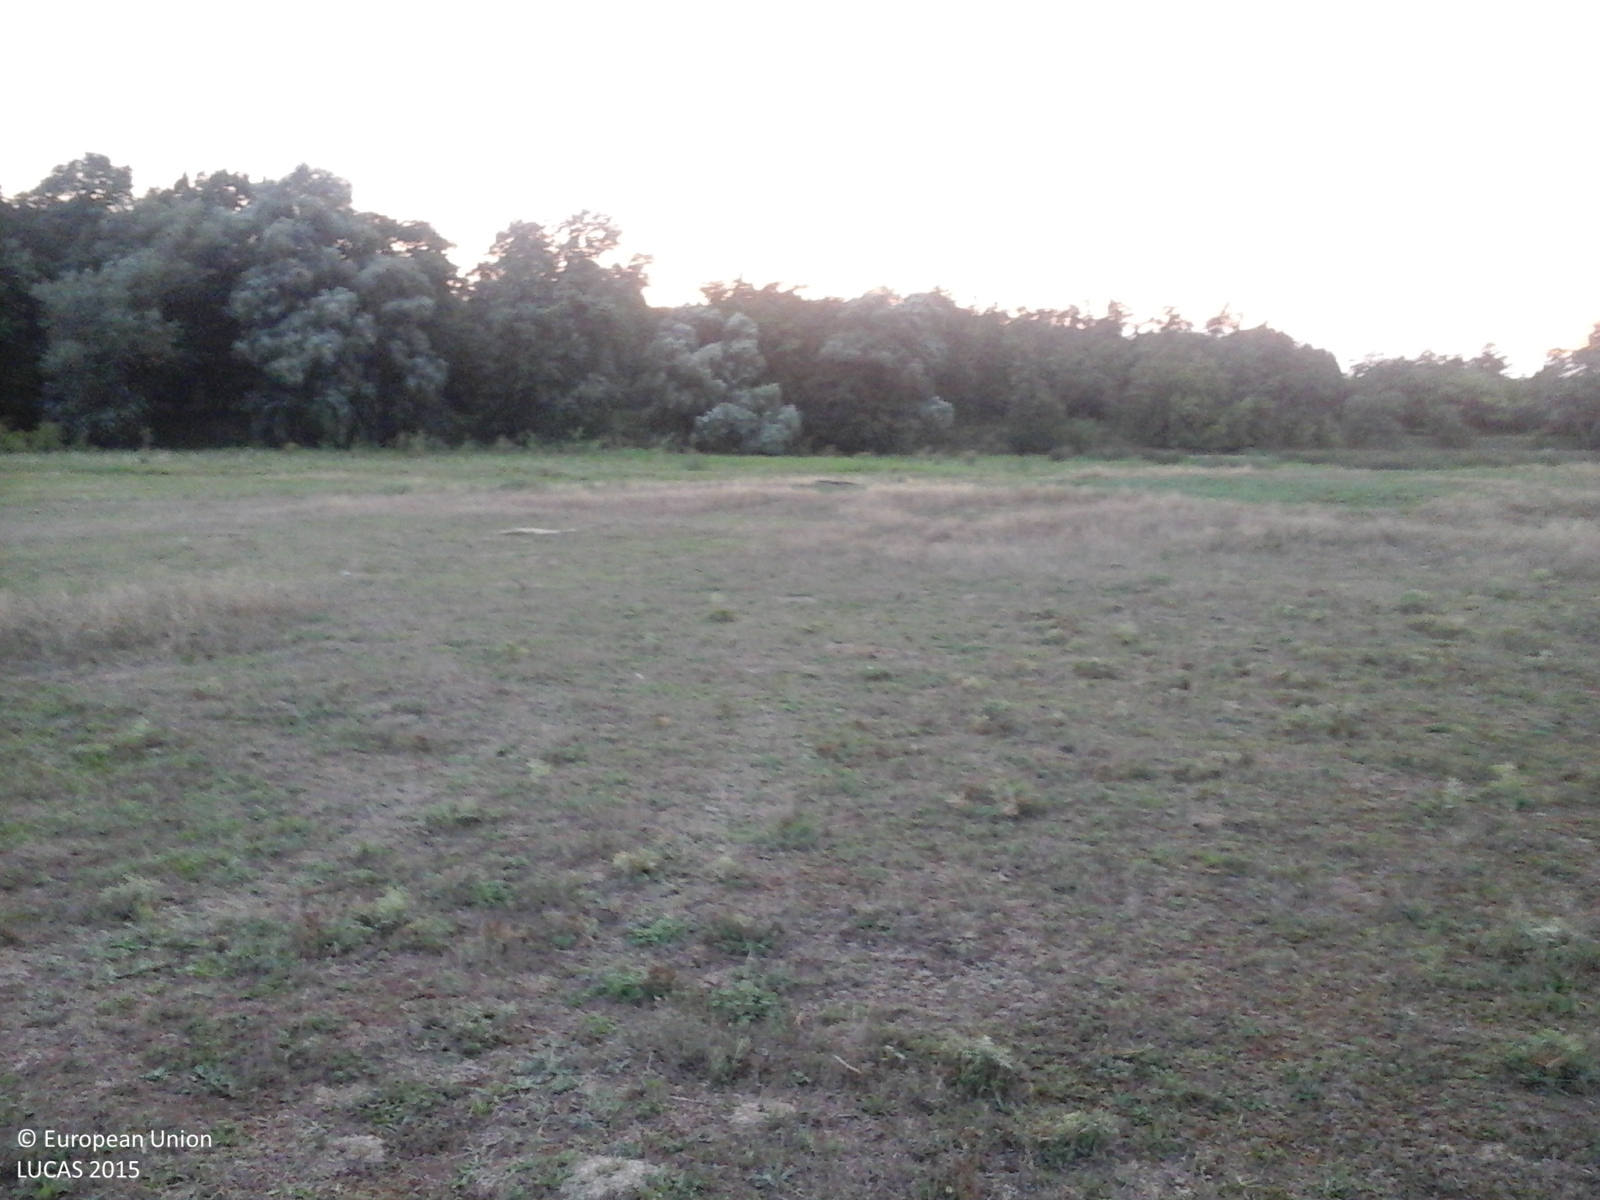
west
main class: Grassland
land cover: Grassland without tree/shrub cover
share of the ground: > 75 %
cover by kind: herbaceous plants 100 %
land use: Agriculture (excluding fallow land and kitchen gardens)
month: July
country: RO
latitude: 43.8837
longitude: 24.6938
